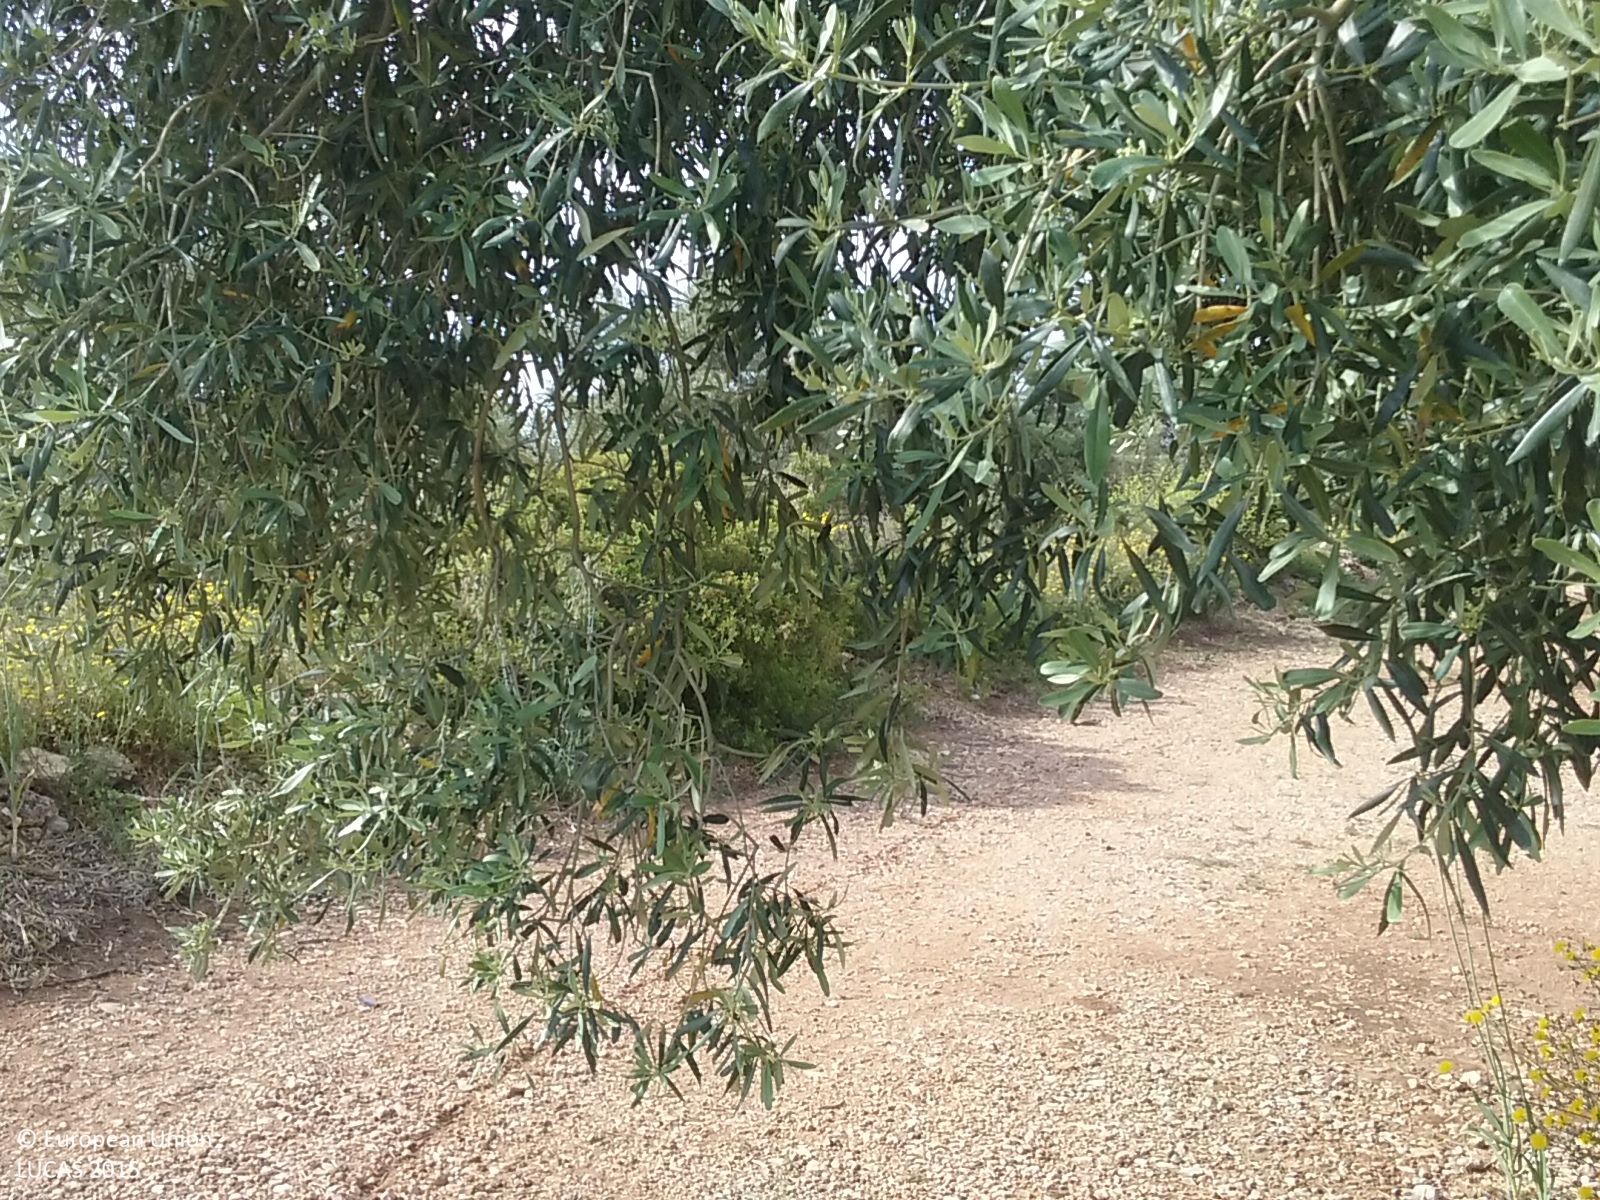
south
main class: Cropland
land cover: Olive groves
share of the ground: 25 - 50 %
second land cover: Spontaneously vegetated surfaces
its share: 25 - 50 %
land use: Agriculture (excluding fallow land and kitchen gardens)
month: May
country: ES
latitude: 40.6221
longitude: 0.2893
